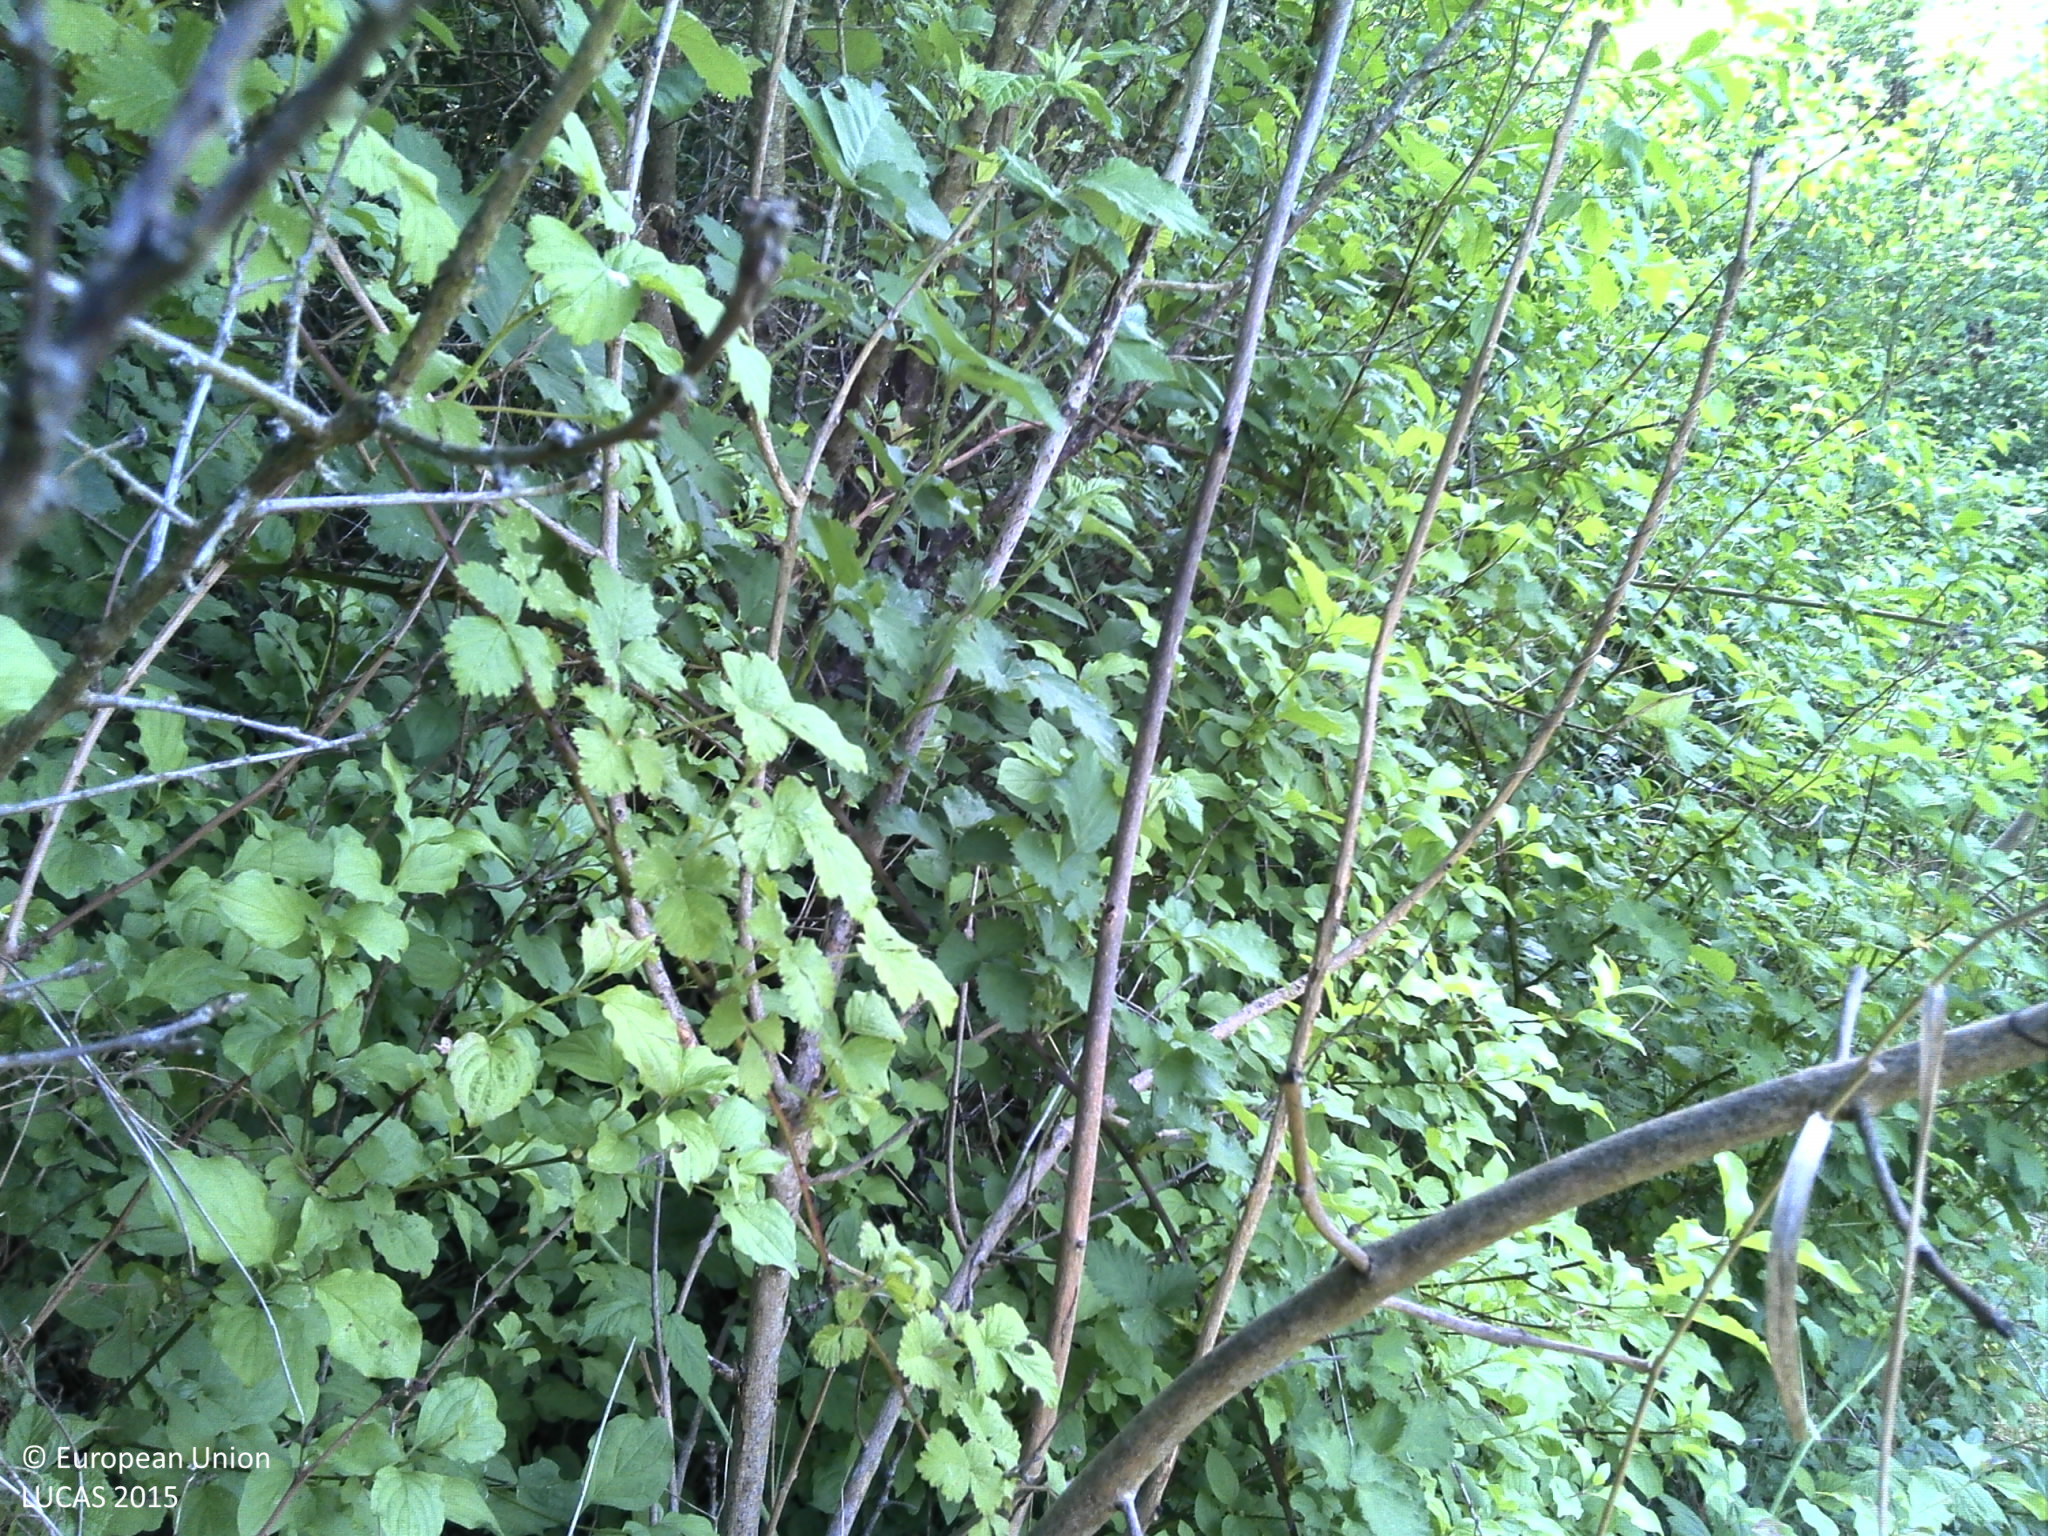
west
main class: Grassland
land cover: Grassland without tree/shrub cover
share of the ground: > 75 %
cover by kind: herbaceous plants 100 %
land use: Agriculture (excluding fallow land and kitchen gardens)
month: June
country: FR
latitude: 49.0363
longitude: 6.0738
